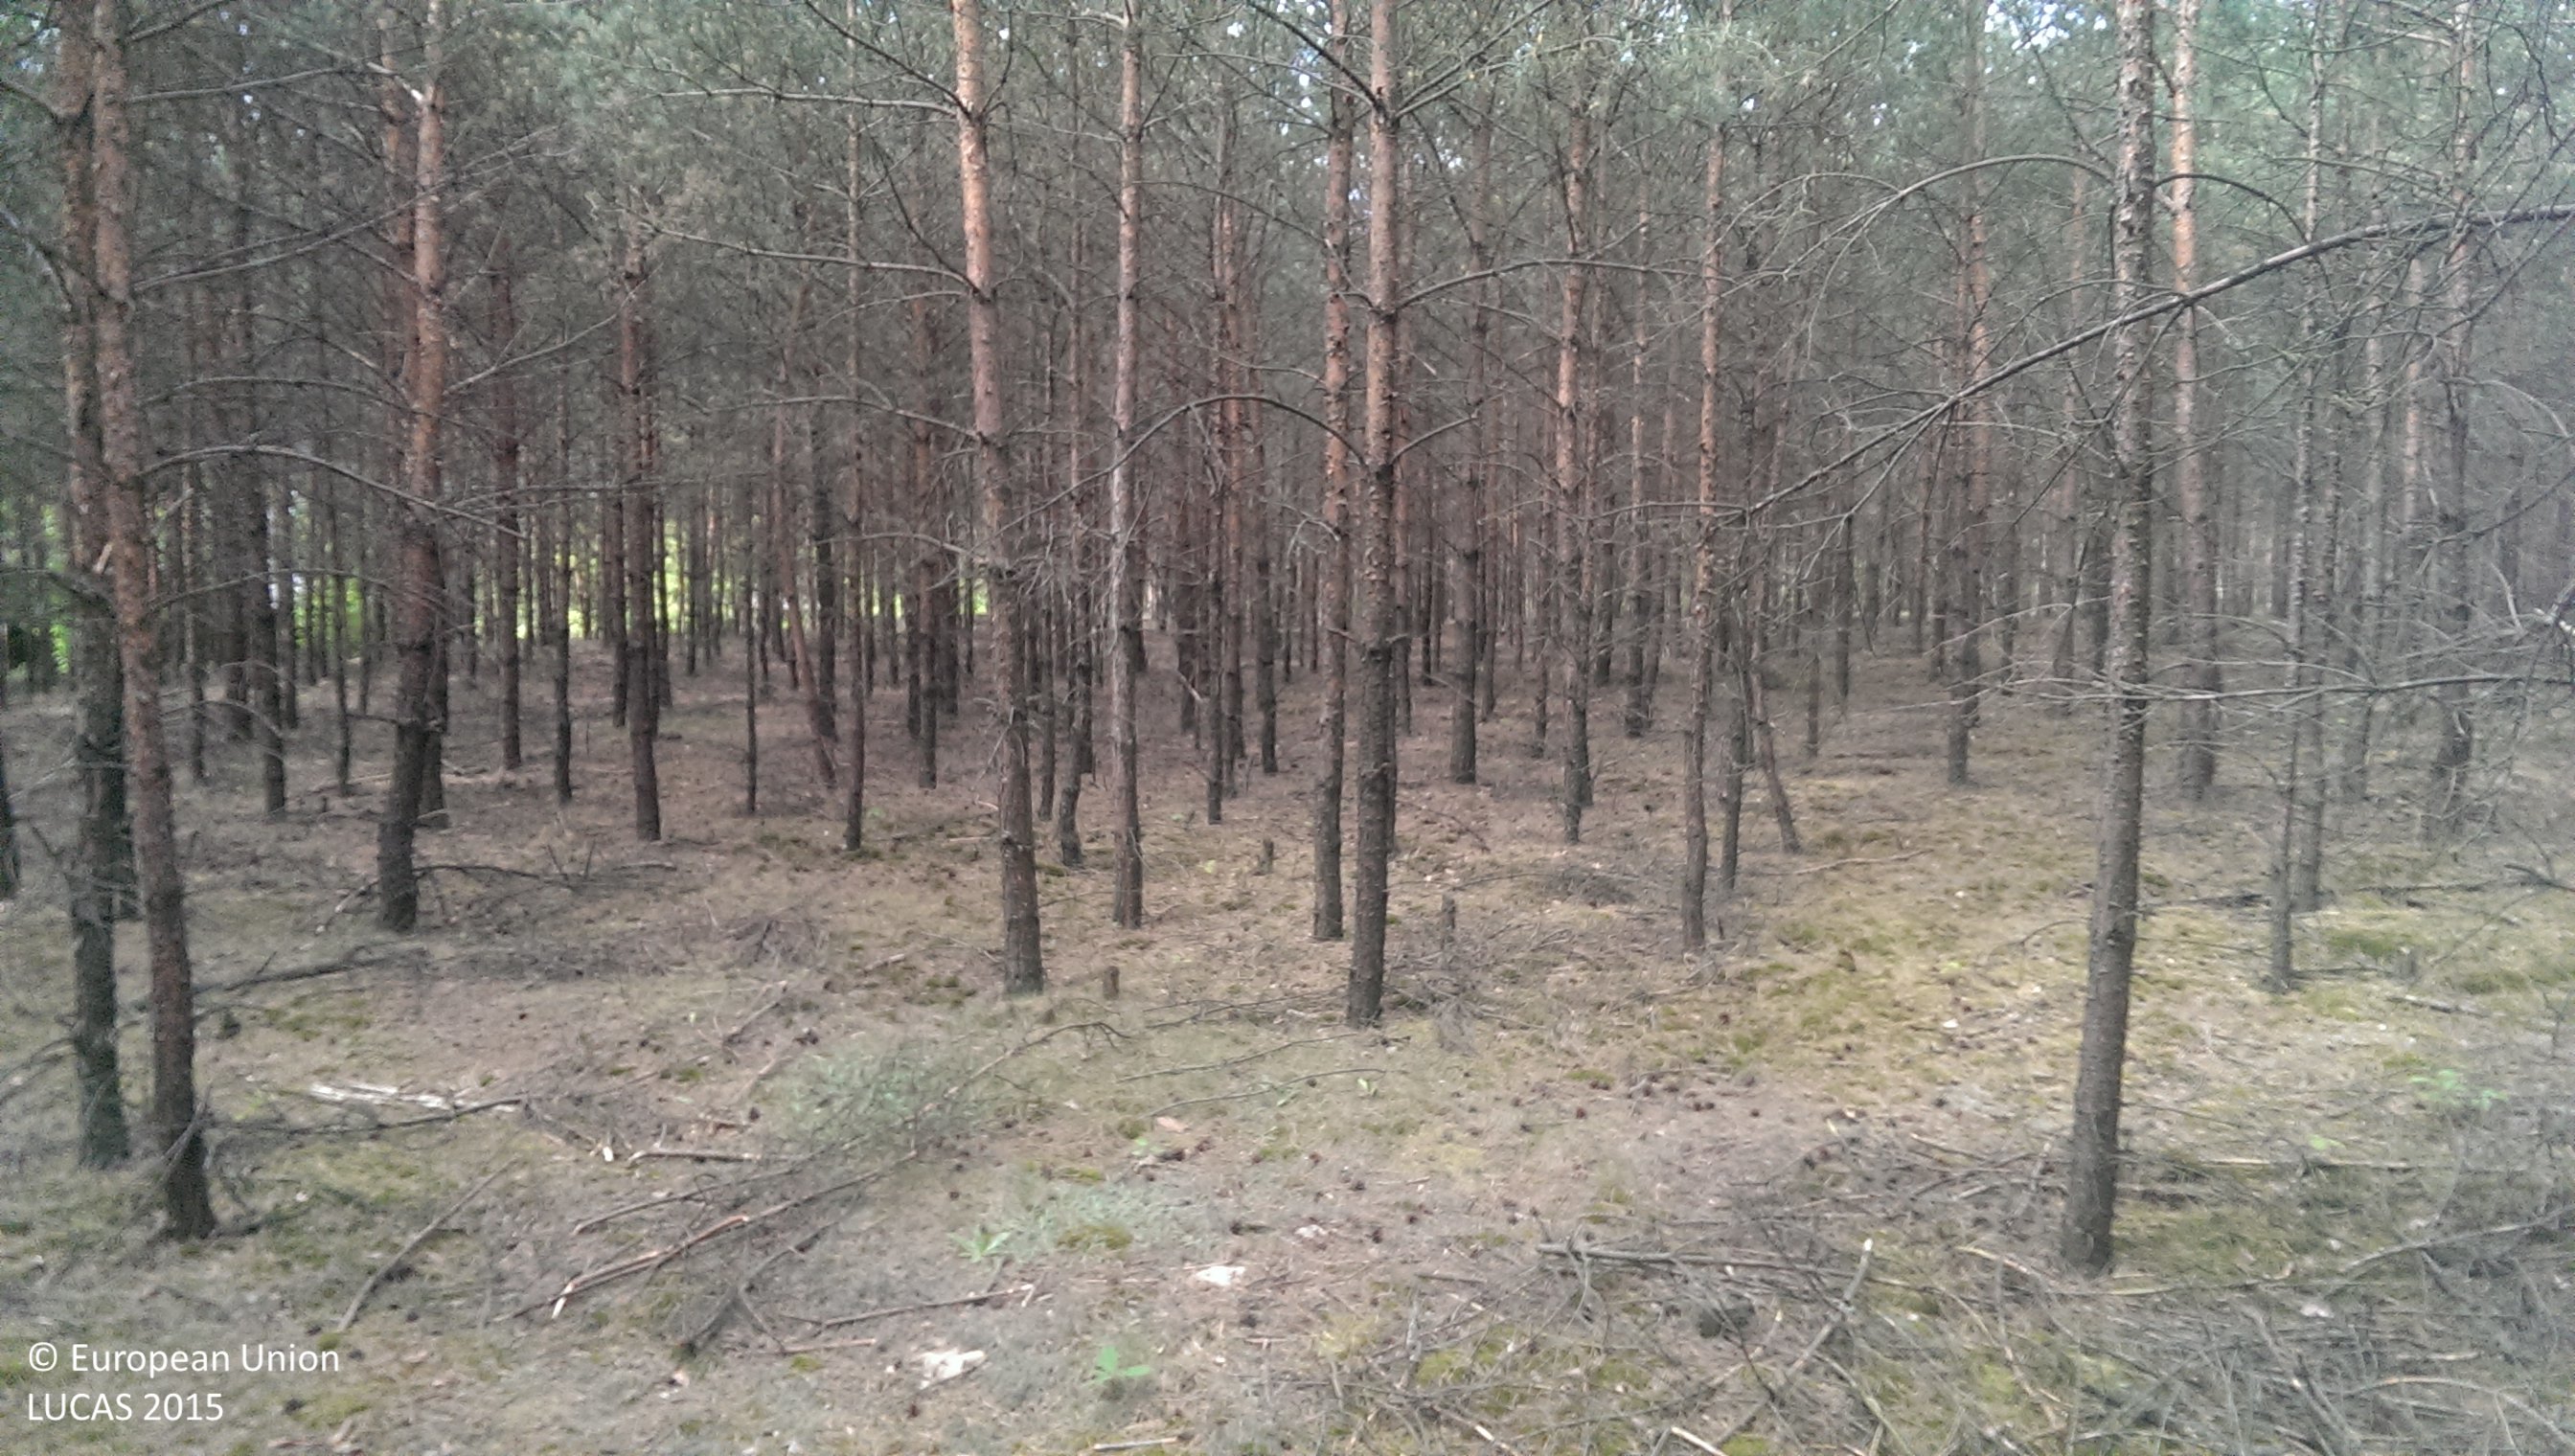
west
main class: Woodland
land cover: Pine dominated coniferous woodland
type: hemiboreal forest and nemoral coniferous forest and mixed broadleaved-coniferous forest
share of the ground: 50 - 75 %
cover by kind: coniferous forest trees 55 %, lichens and mosses 40 %, broadleaved forest trees 5 %
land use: Forestry
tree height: > 5 m
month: May
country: PL
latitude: 52.3230
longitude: 16.2126
